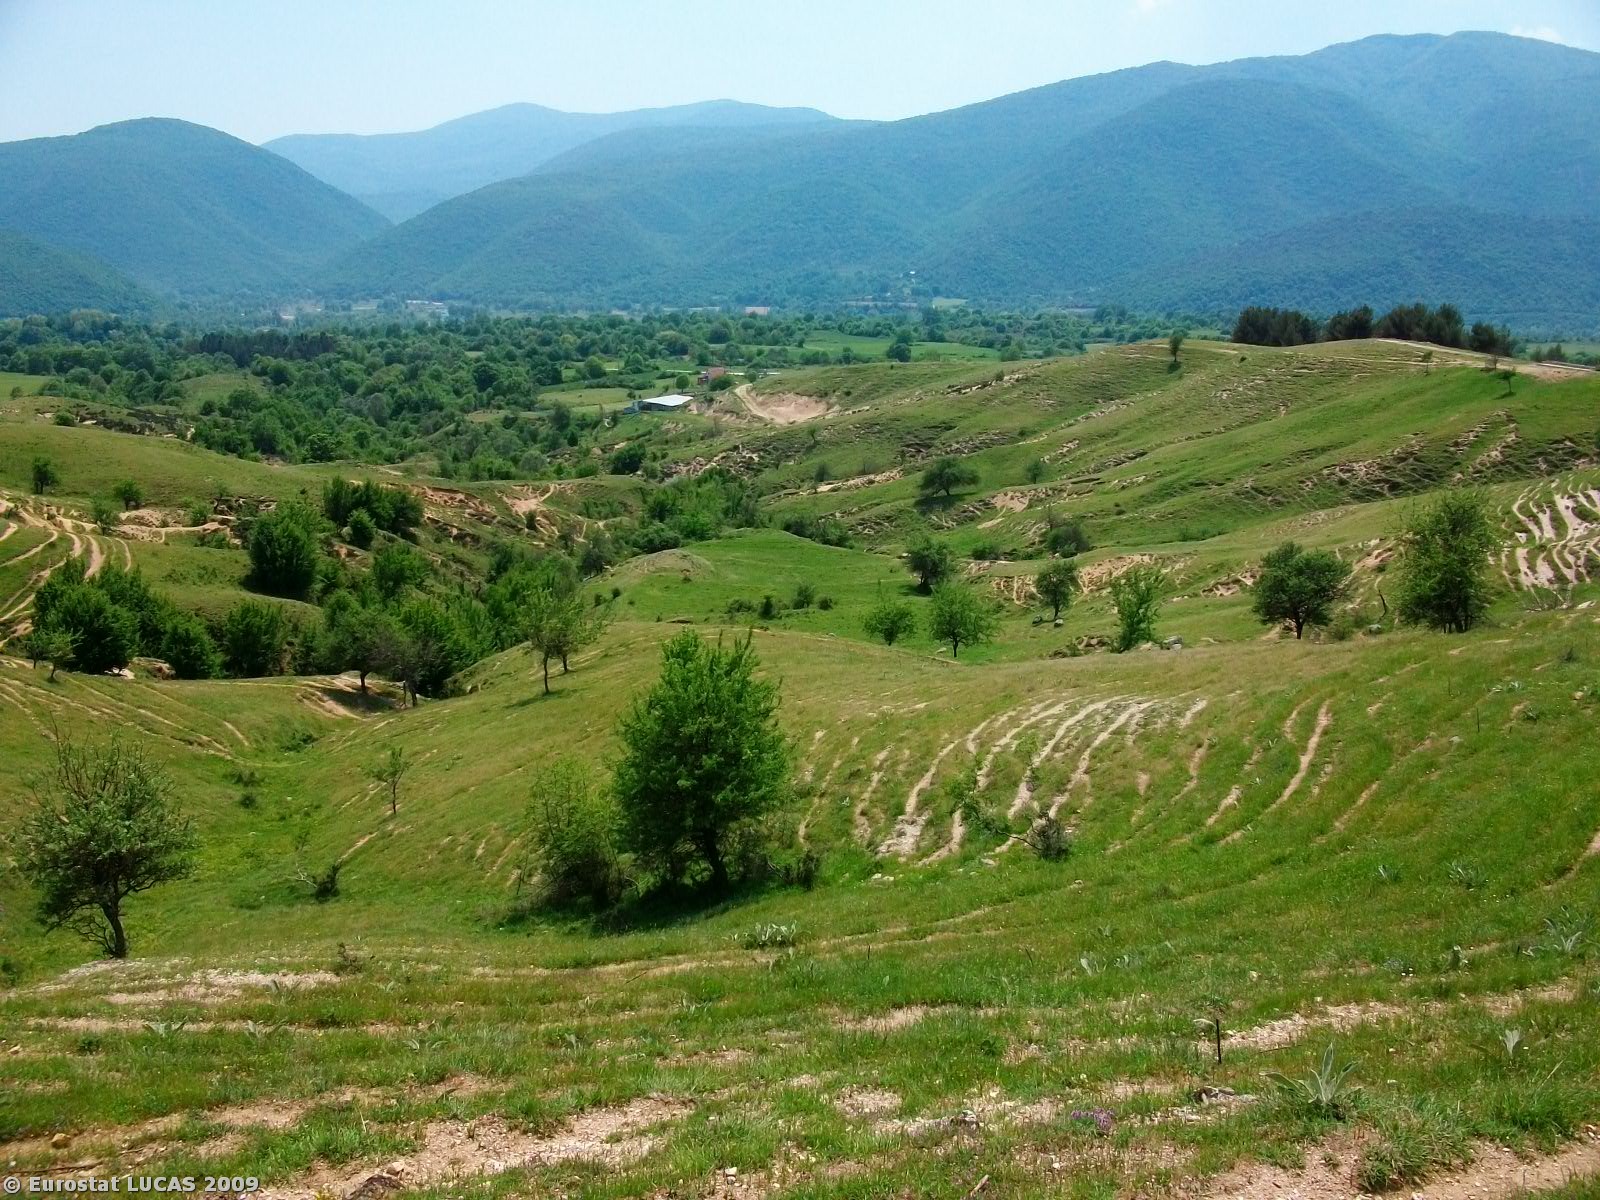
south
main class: Grassland
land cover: Grassland without tree/shrub cover
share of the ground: 50 - 75 %
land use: Agriculture (excluding fallow land and kitchen gardens)
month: May
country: GR
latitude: 41.2369
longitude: 24.6303
